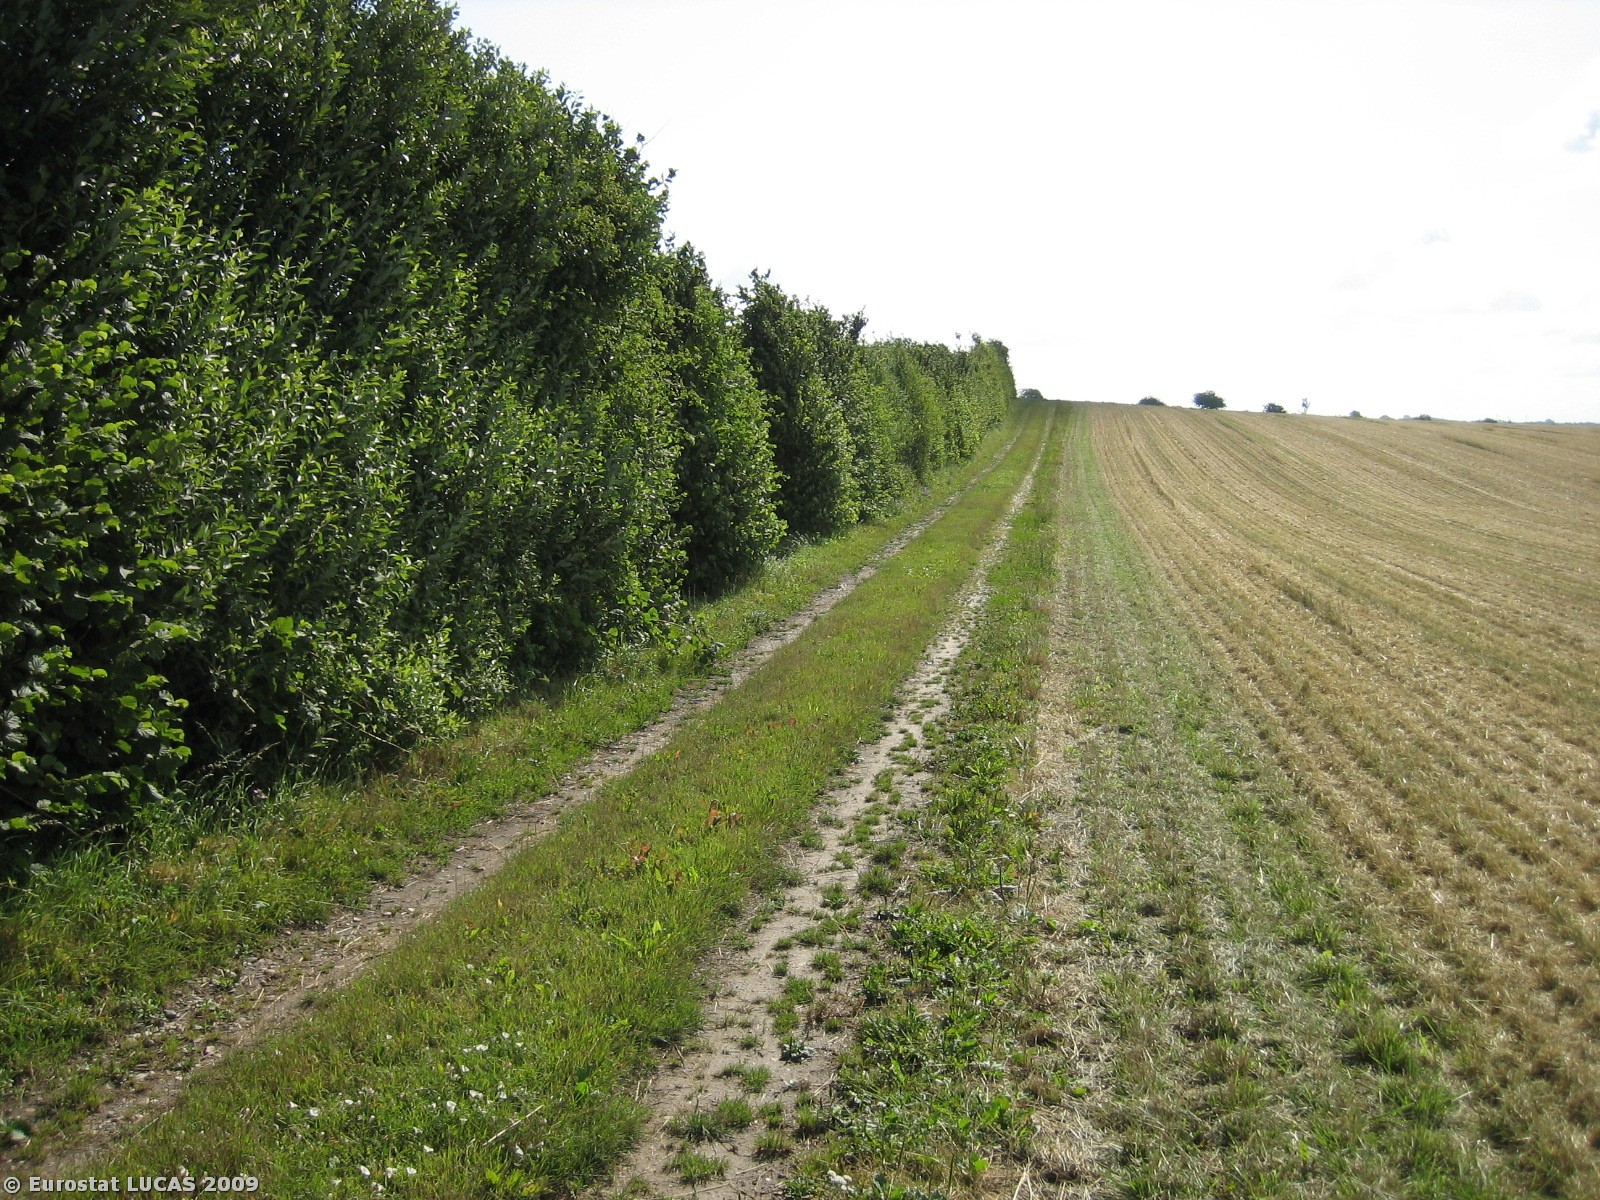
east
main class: Cropland
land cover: Temporary grasslands
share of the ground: > 75 %
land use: Agriculture (excluding fallow land and kitchen gardens)
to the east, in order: Temporary grasslands; Tracks; Managed hedges; Barley; Managed hedges; Tracks; Spontaneously vegetated surfaces; Temporary grasslands
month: July
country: DK
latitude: 55.3608
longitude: 9.8582
